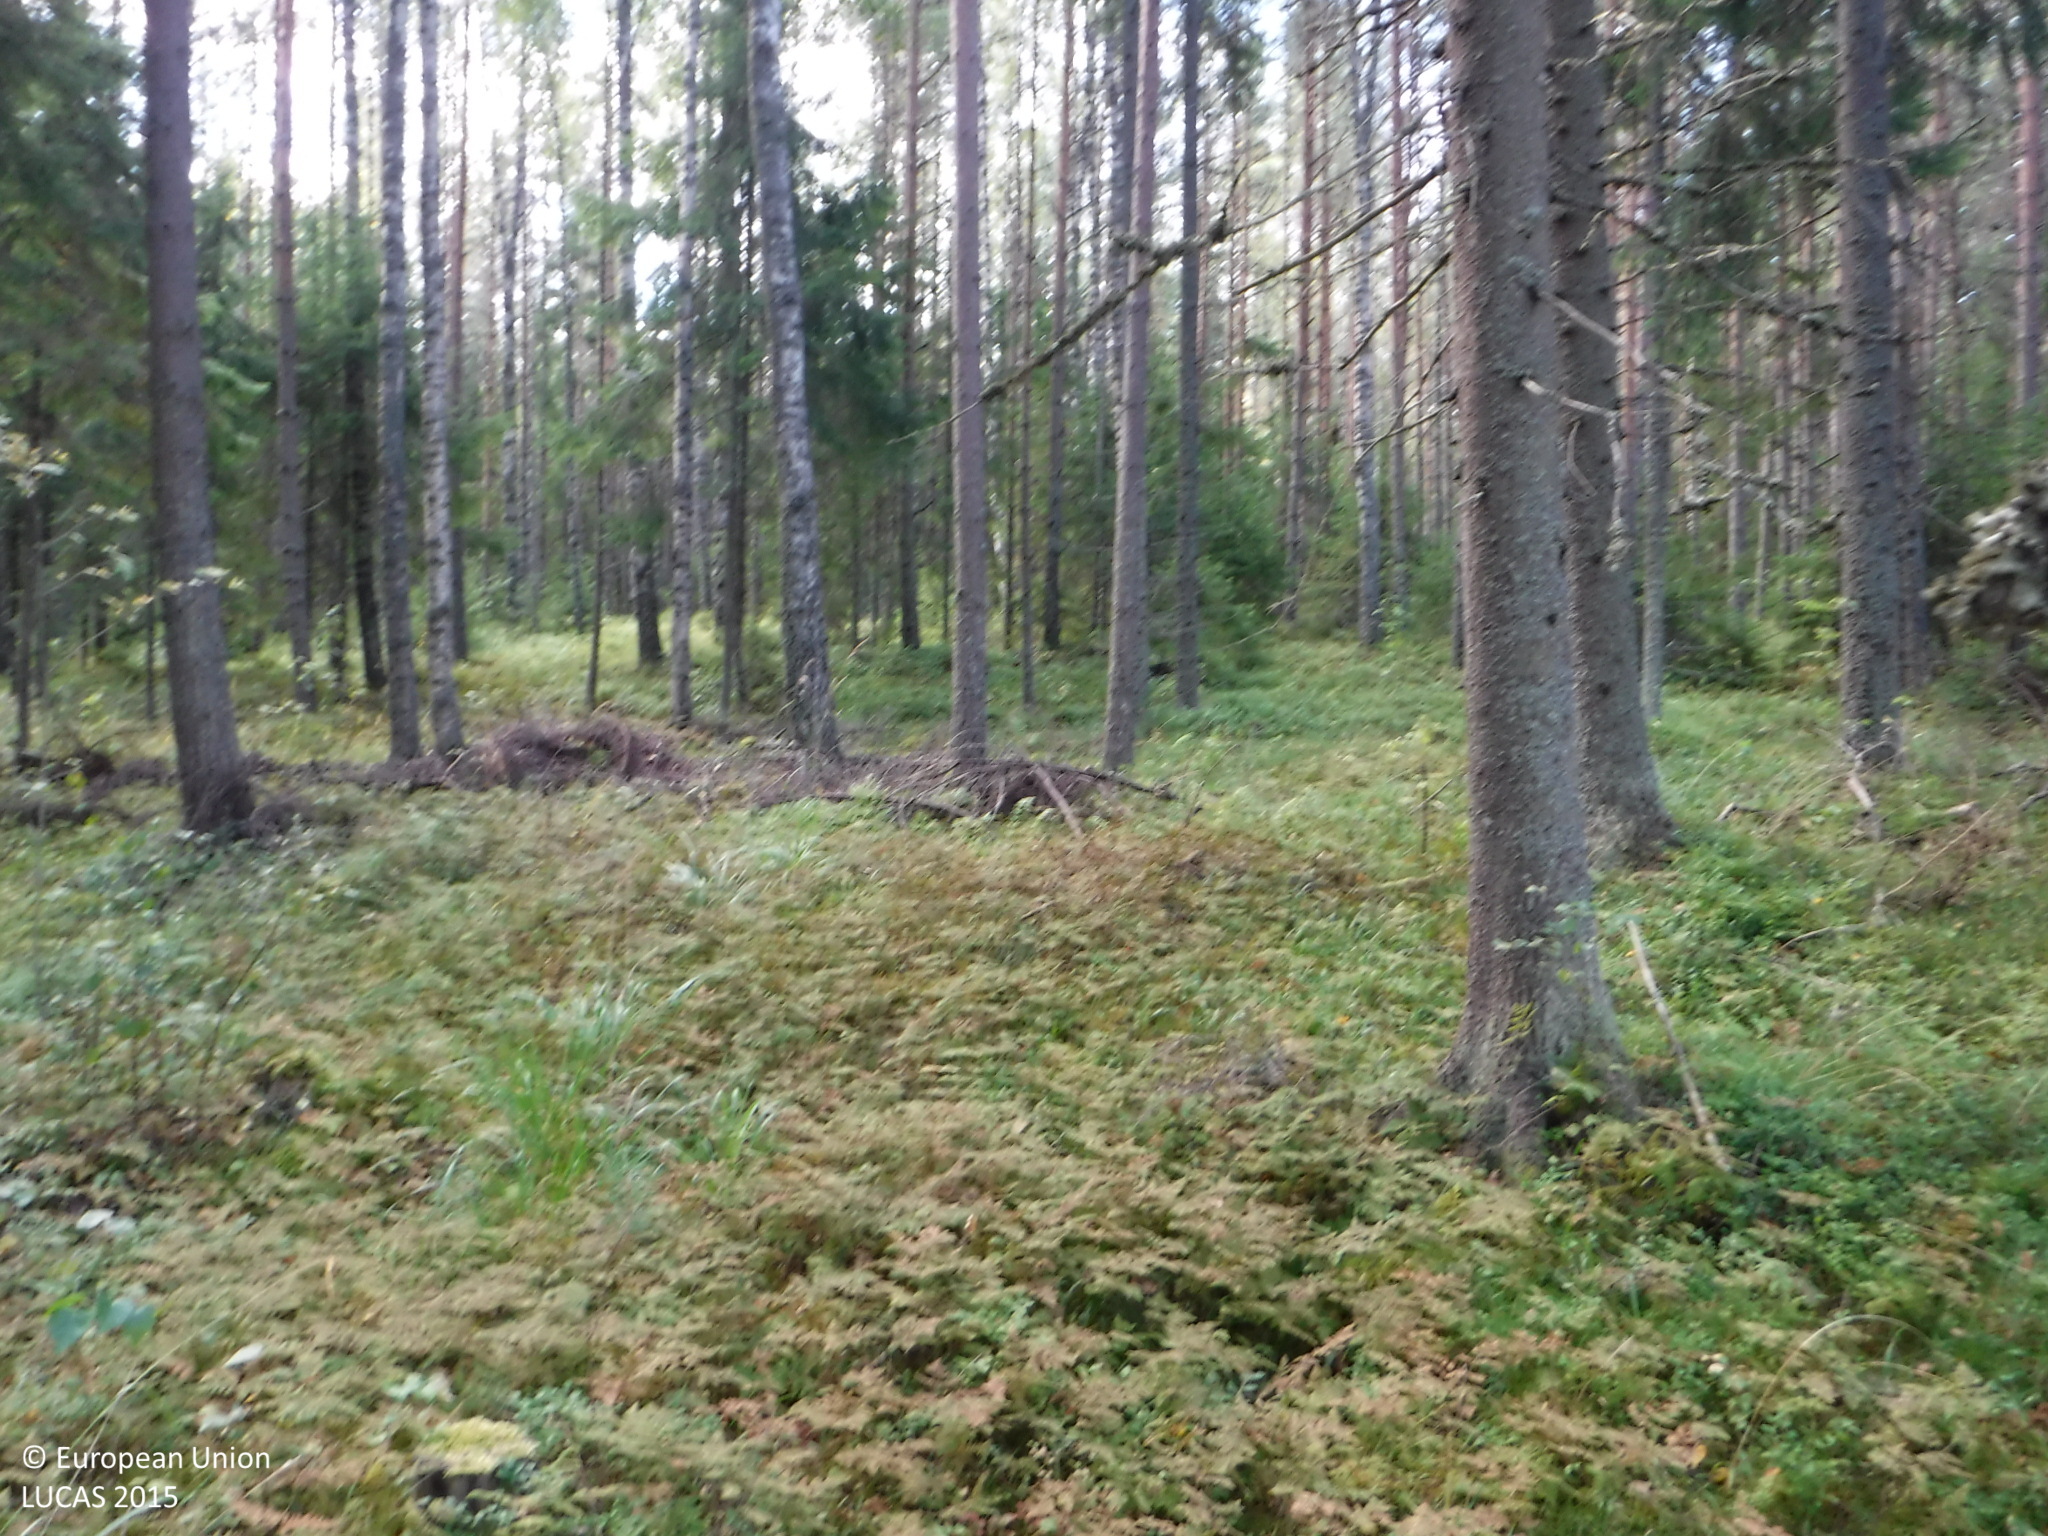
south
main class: Woodland
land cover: Spruce dominated coniferous woodland
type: boreal forest
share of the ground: 50 - 75 %
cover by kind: coniferous forest trees 70 %, shrubs 15 %, herbaceous plants 10 %, lichens and mosses 5 %
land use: Forestry
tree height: > 5 m
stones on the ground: < 10 %
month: August
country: FI
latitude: 61.3064
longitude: 22.0263
